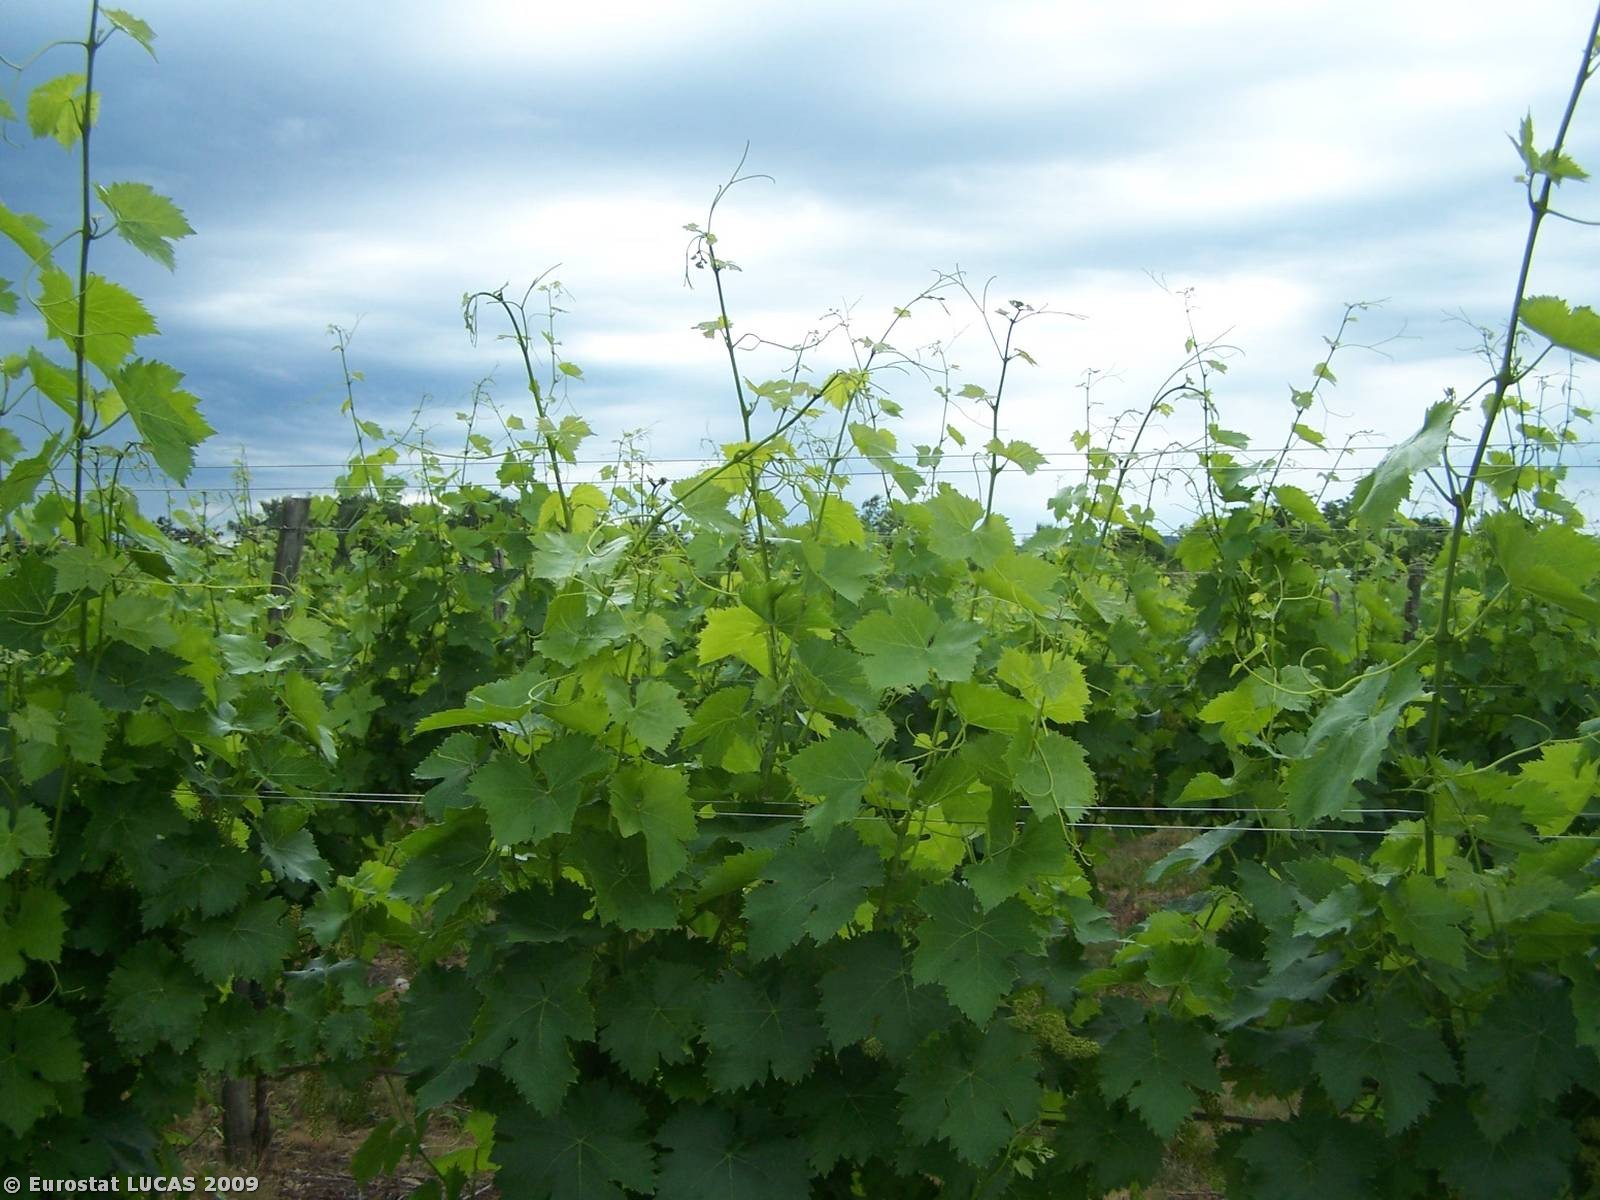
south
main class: Cropland
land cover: Vineyards
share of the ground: 50 - 75 %
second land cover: Grassland with sparse tree/shrub cover
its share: 50 - 75 %
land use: Agriculture (excluding fallow land and kitchen gardens)
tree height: < 5 m
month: May
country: IT
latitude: 45.9328
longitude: 13.5170
